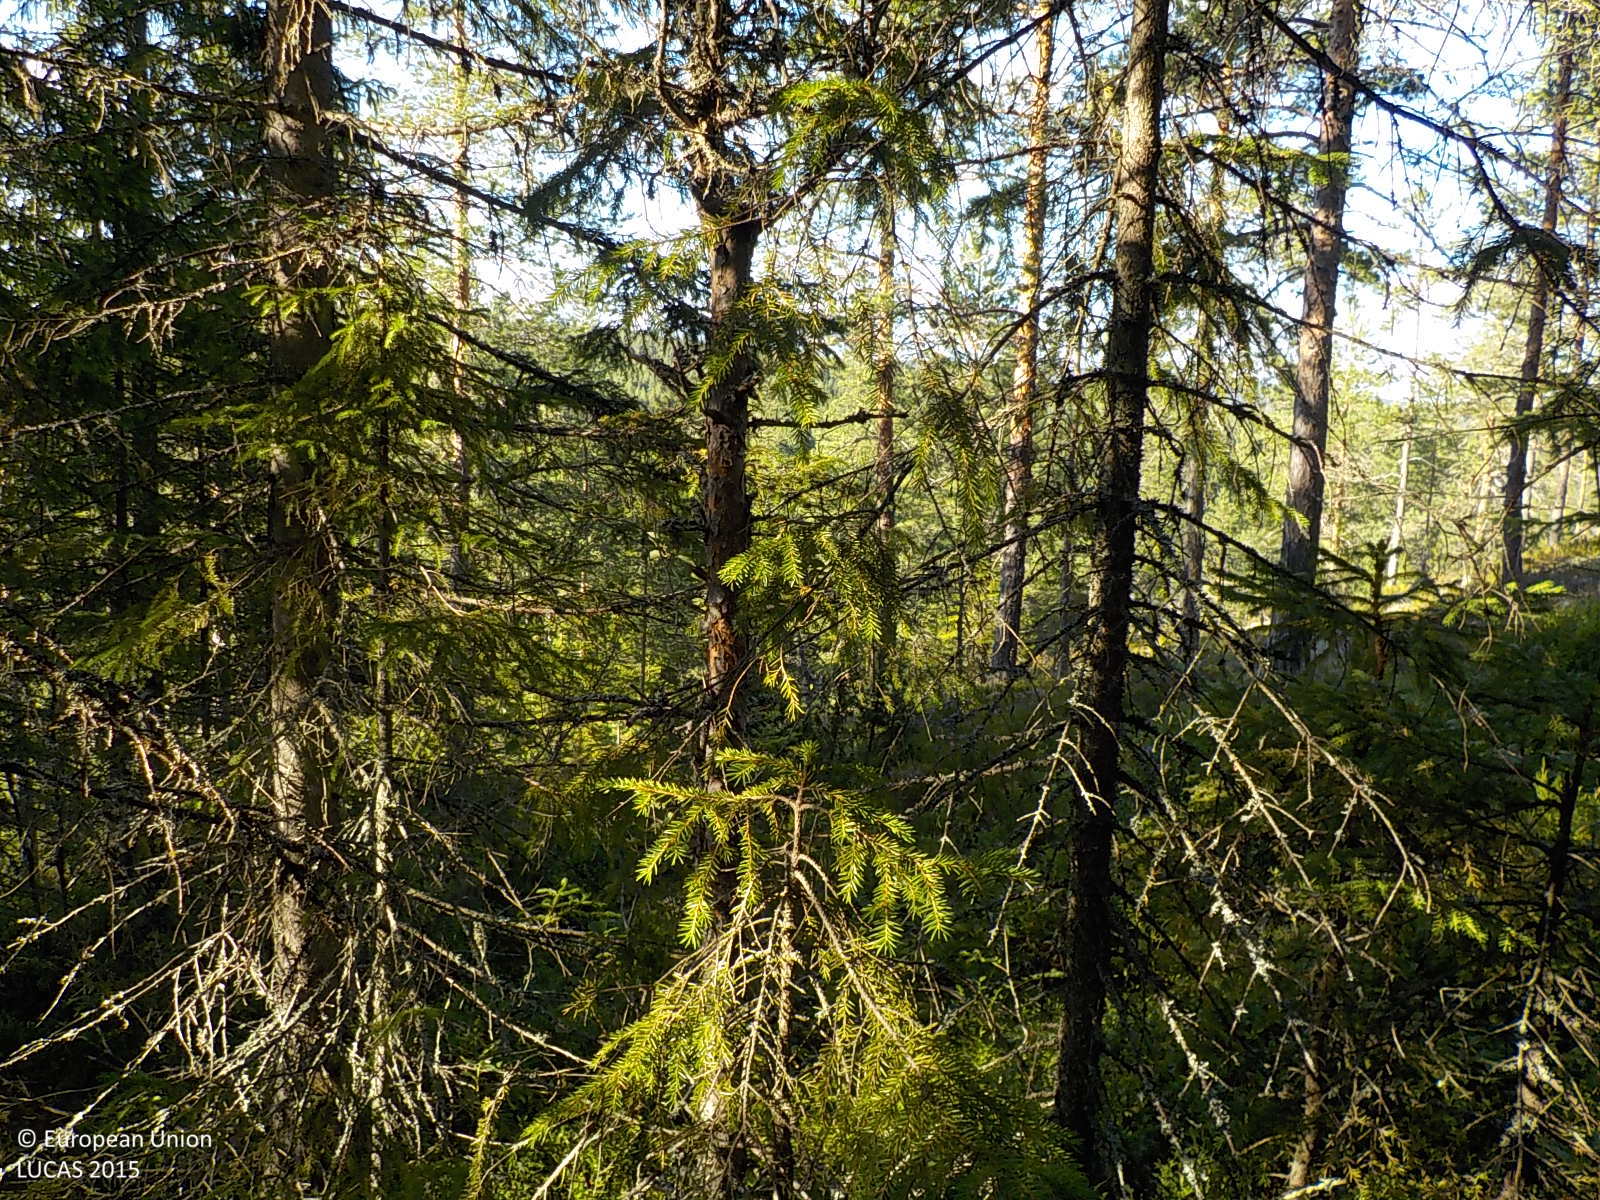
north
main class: Woodland
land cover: Spruce dominated coniferous woodland
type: boreal forest
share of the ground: 50 - 75 %
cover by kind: coniferous forest trees 75 %, shrubs 25 %
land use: Forestry
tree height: > 5 m
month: August
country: SE
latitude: 63.3720
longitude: 18.7973
